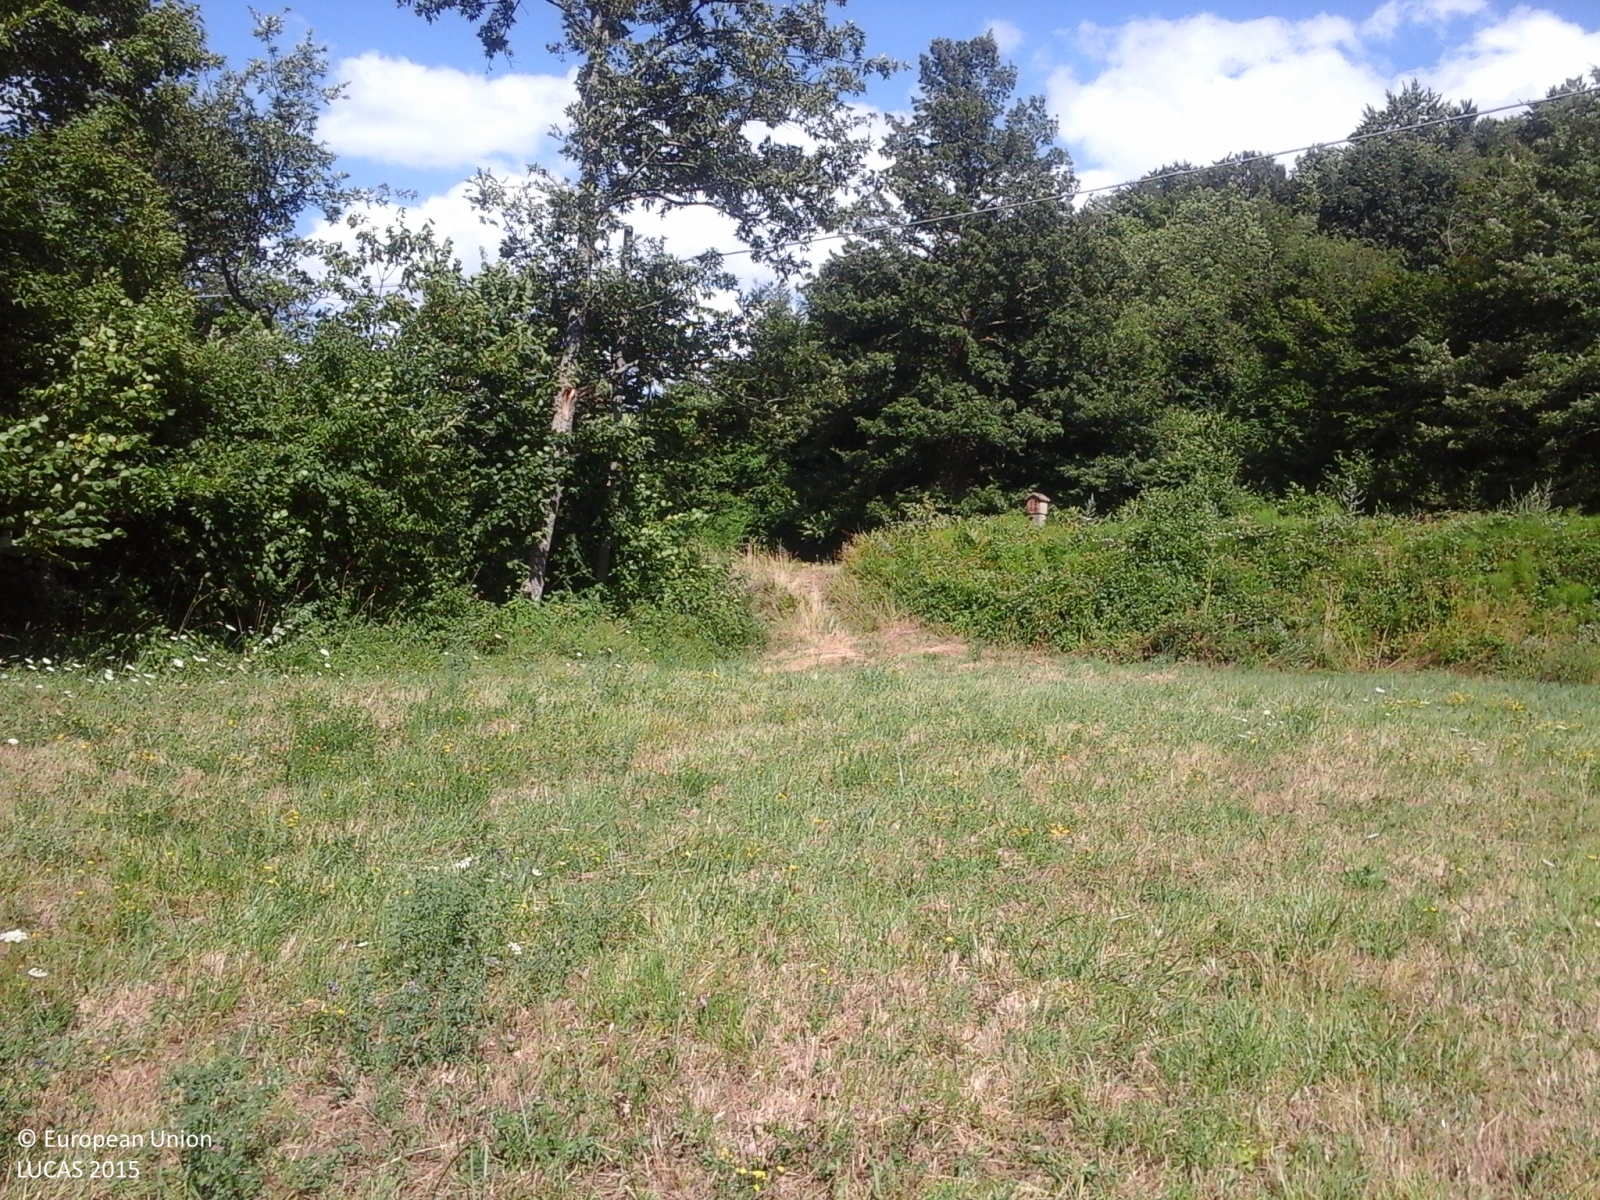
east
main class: Grassland
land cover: Grassland without tree/shrub cover
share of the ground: > 75 %
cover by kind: herbaceous plants 100 %
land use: Agriculture (excluding fallow land and kitchen gardens)
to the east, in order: Grassland without tree/shrub cover; Electric lines; Grassland without tree/shrub cover; Shruby margins; Paved roads, cycling and walking lanes; Grassland without tree/shrub cover; Rocks and stones; Broadleaved woodland
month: July
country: IT
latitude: 43.7669
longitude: 12.2428
